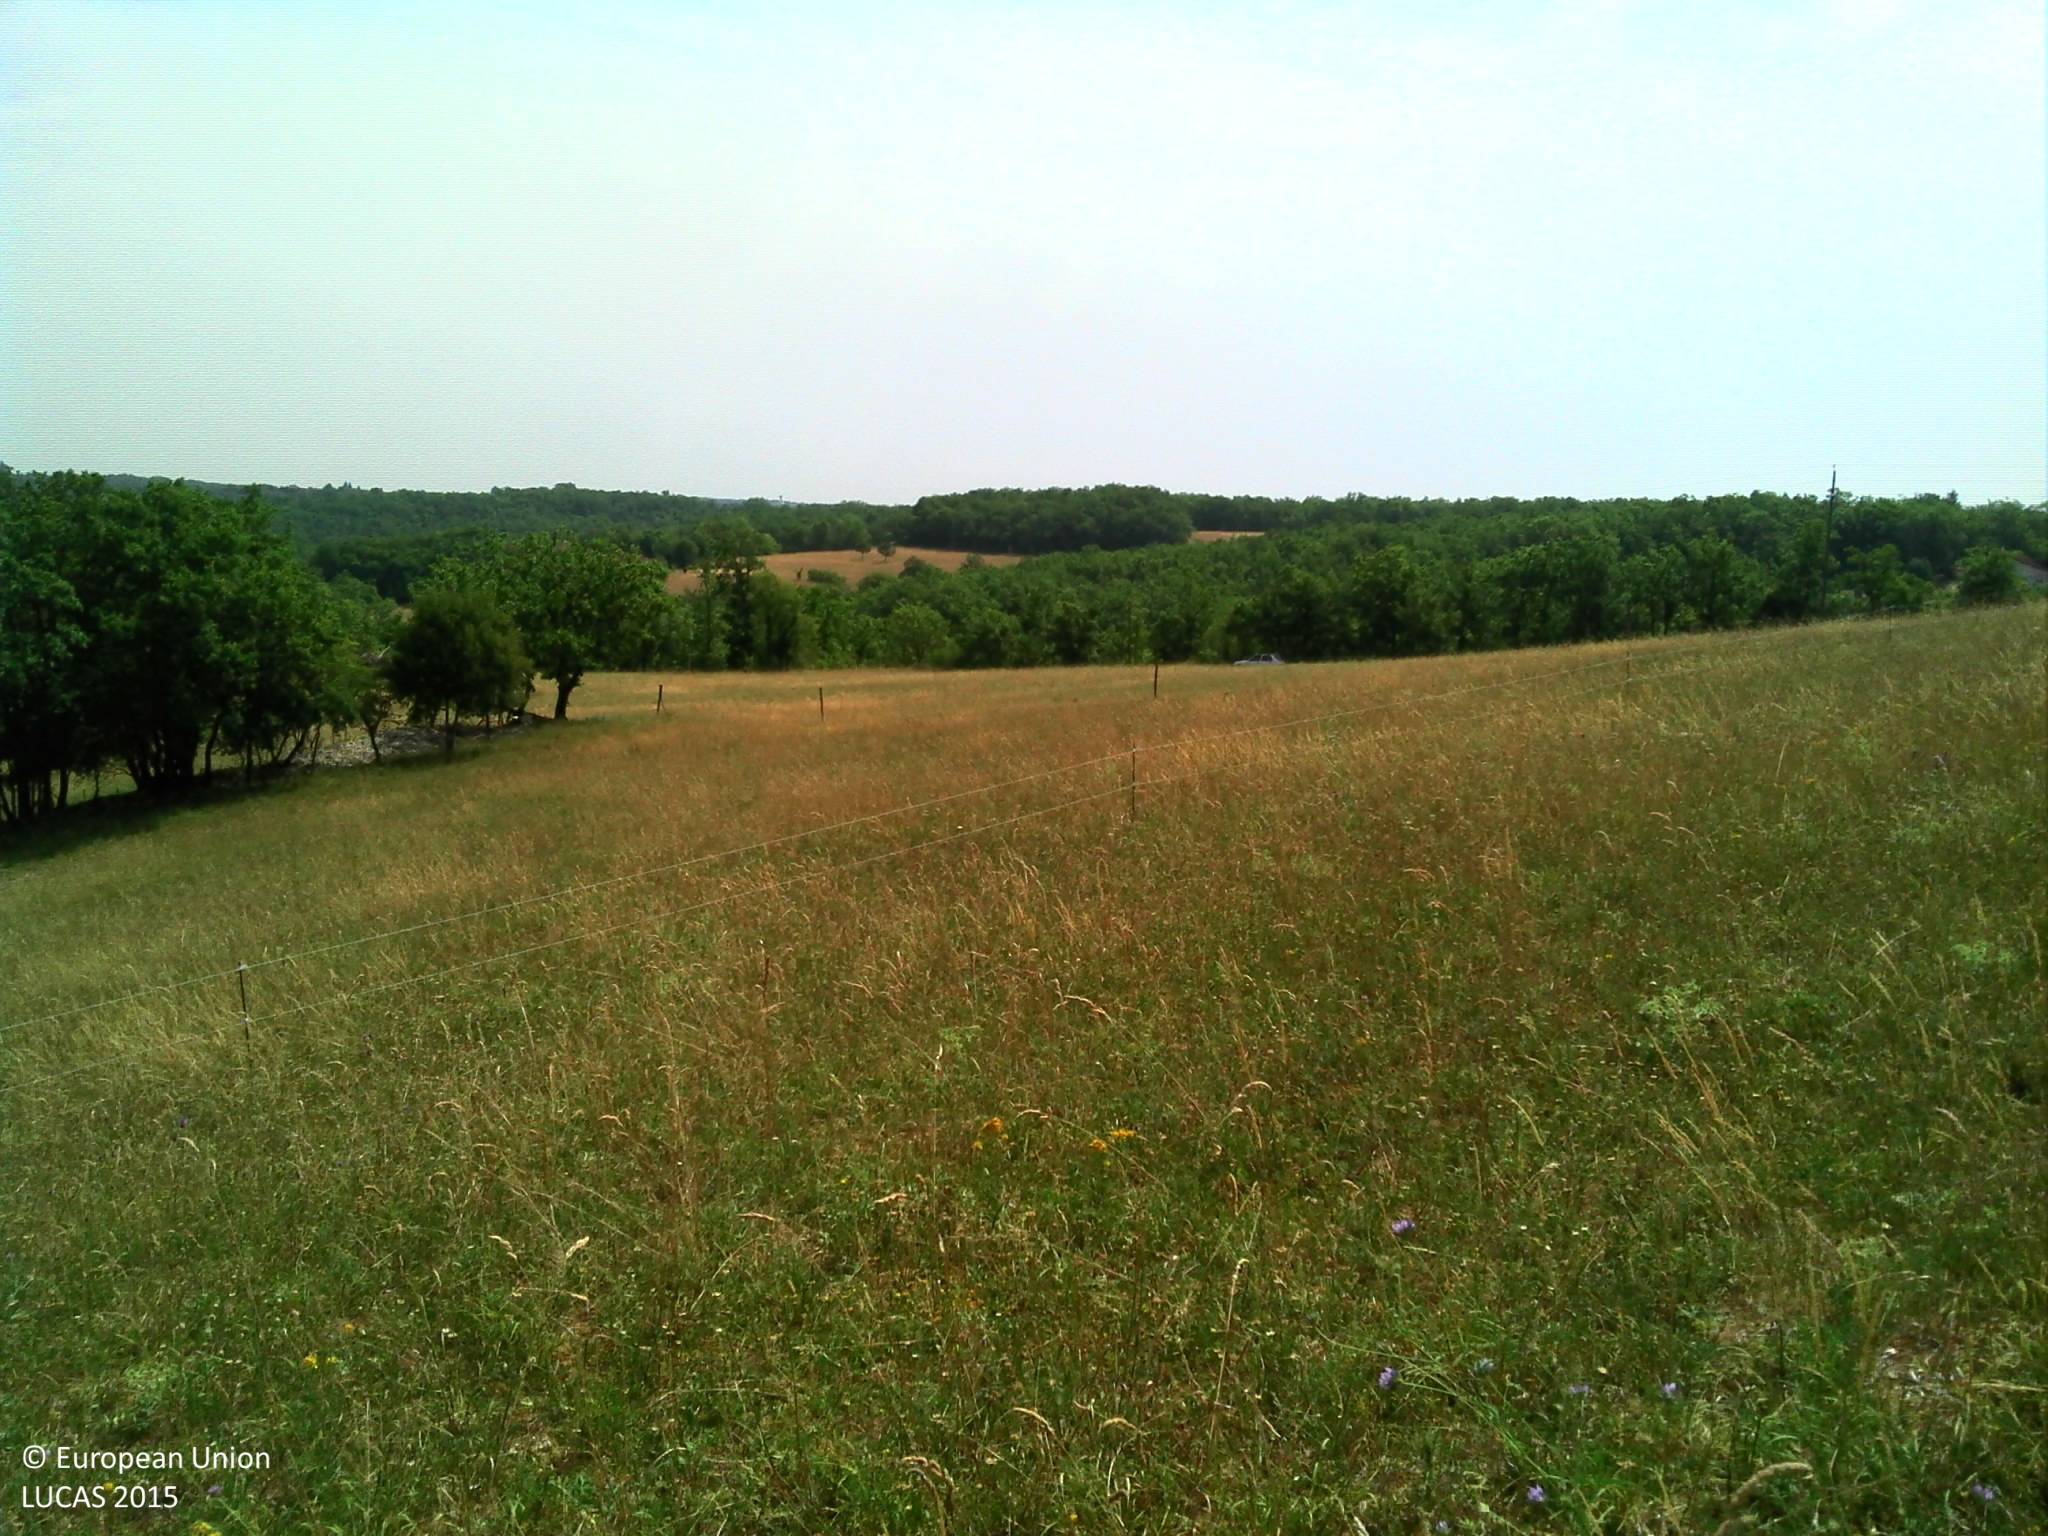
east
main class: Grassland
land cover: Grassland without tree/shrub cover
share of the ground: > 75 %
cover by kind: herbaceous plants 100 %
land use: Agriculture (excluding fallow land and kitchen gardens)
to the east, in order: Grassland without tree/shrub cover; Fences; Grassland without tree/shrub cover; Fences; Grassland without tree/shrub cover; Electric lines; Fences; Grass margins; Paved roads, cycling and walking lanes; Grass margins; Broadleaved woodland; Rock outcrops; Other coniferous woodland; Electric lines; Other mixed woodland
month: July
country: FR
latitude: 44.4495
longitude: 1.0110
